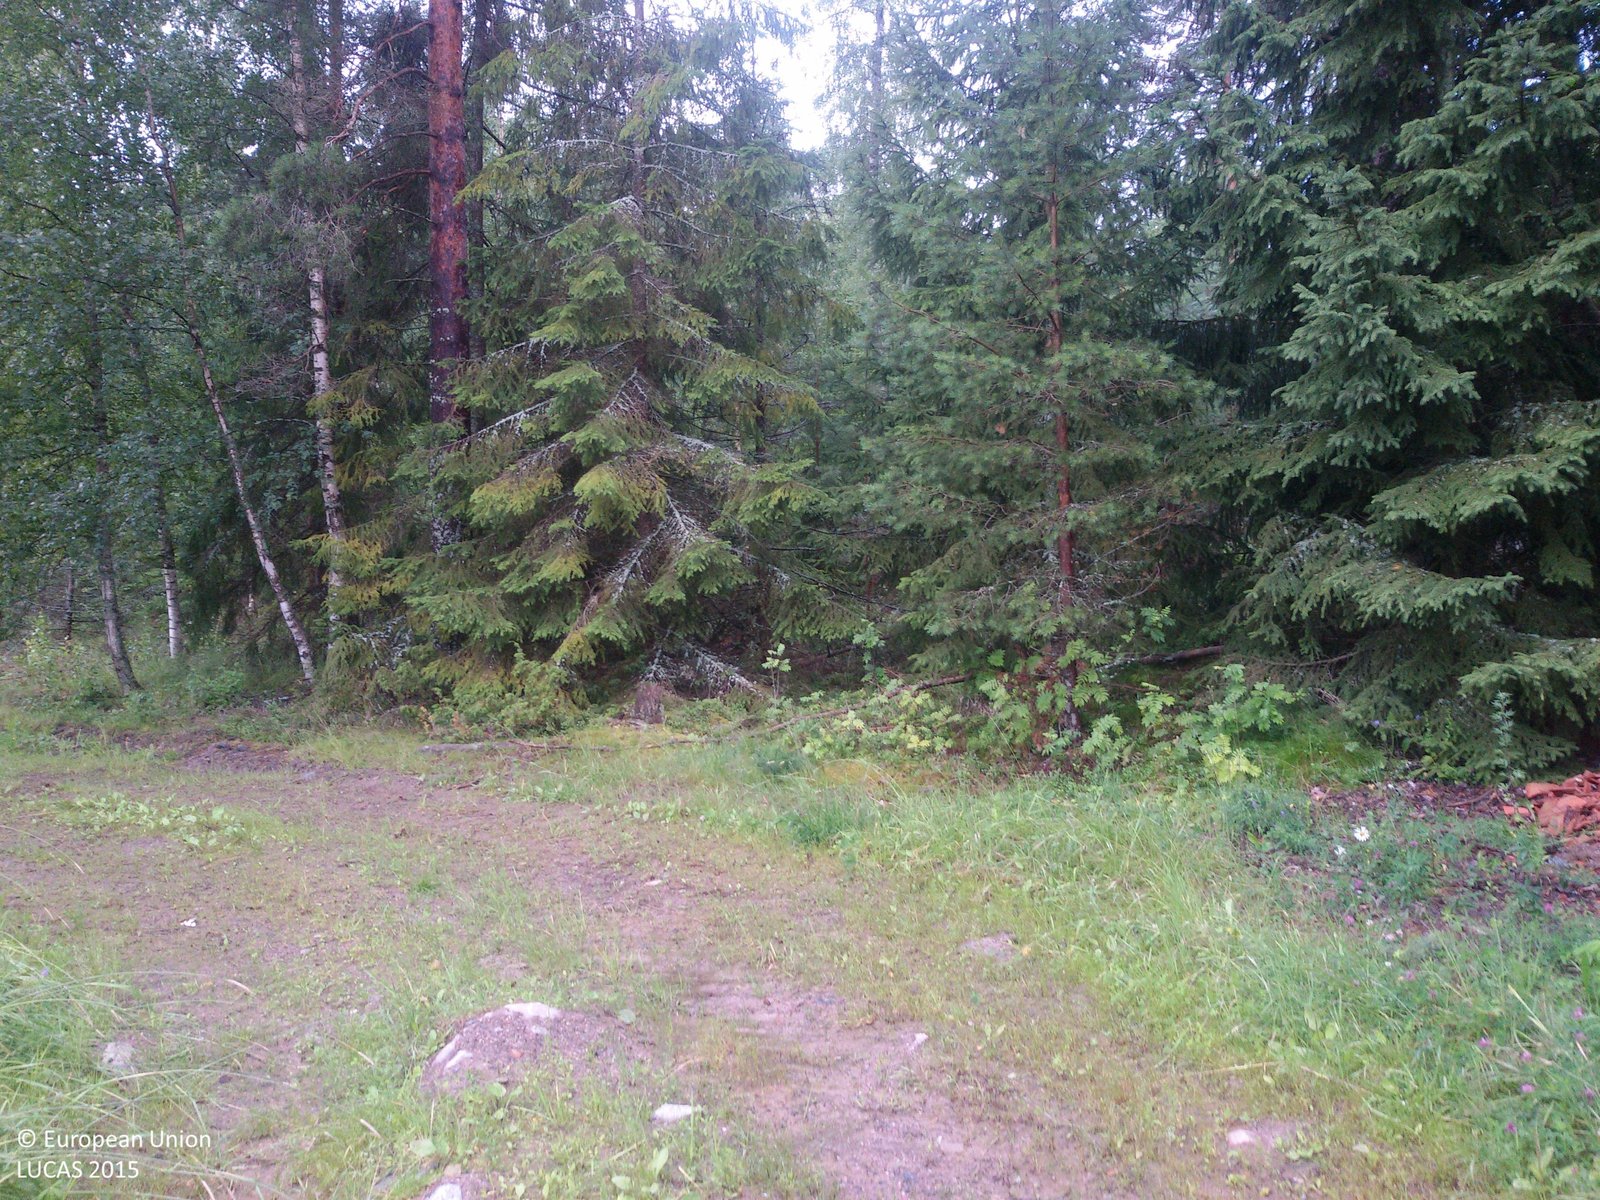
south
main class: Grassland
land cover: Grassland without tree/shrub cover
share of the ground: > 75 %
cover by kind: herbaceous plants 100 %
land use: Agriculture (excluding fallow land and kitchen gardens)
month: July
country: SE
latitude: 60.4994
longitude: 15.6860
